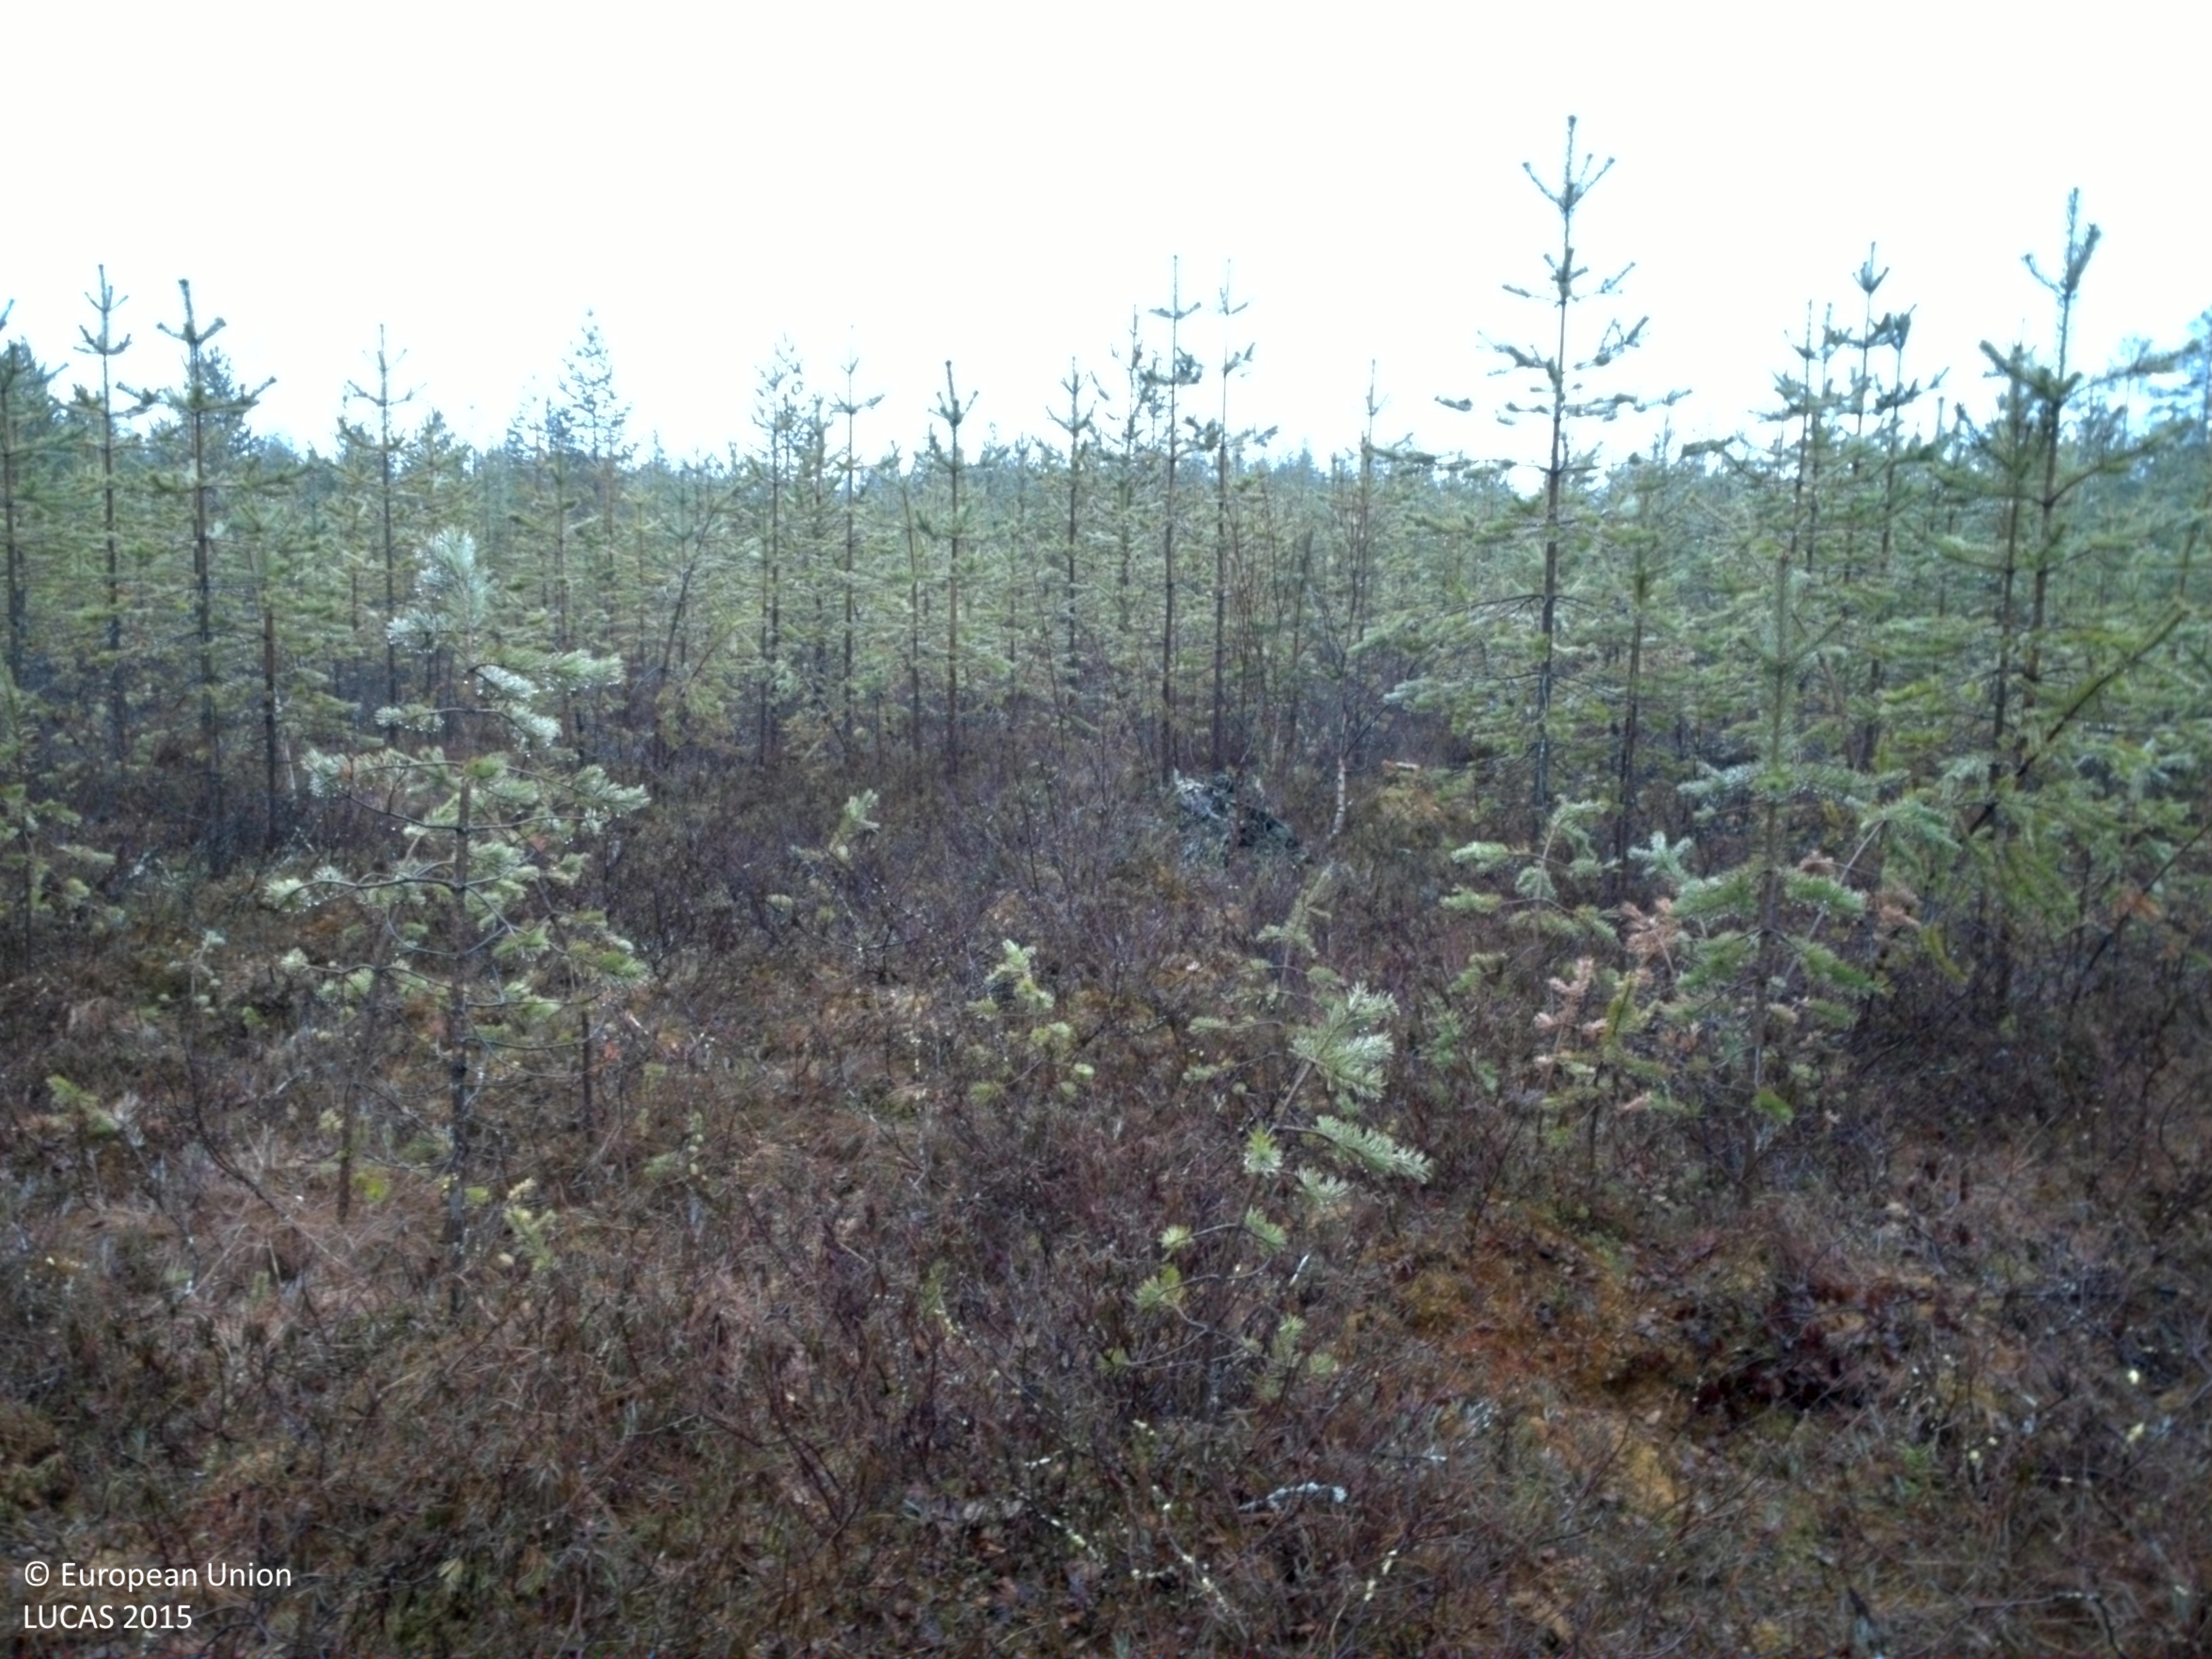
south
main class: Woodland
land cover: Pine dominated coniferous woodland
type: boreal forest
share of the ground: 50 - 75 %
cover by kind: coniferous forest trees 75 %, shrubs 25 %
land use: Forestry
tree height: > 5 m
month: May
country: SE
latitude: 65.8585
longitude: 23.2905
